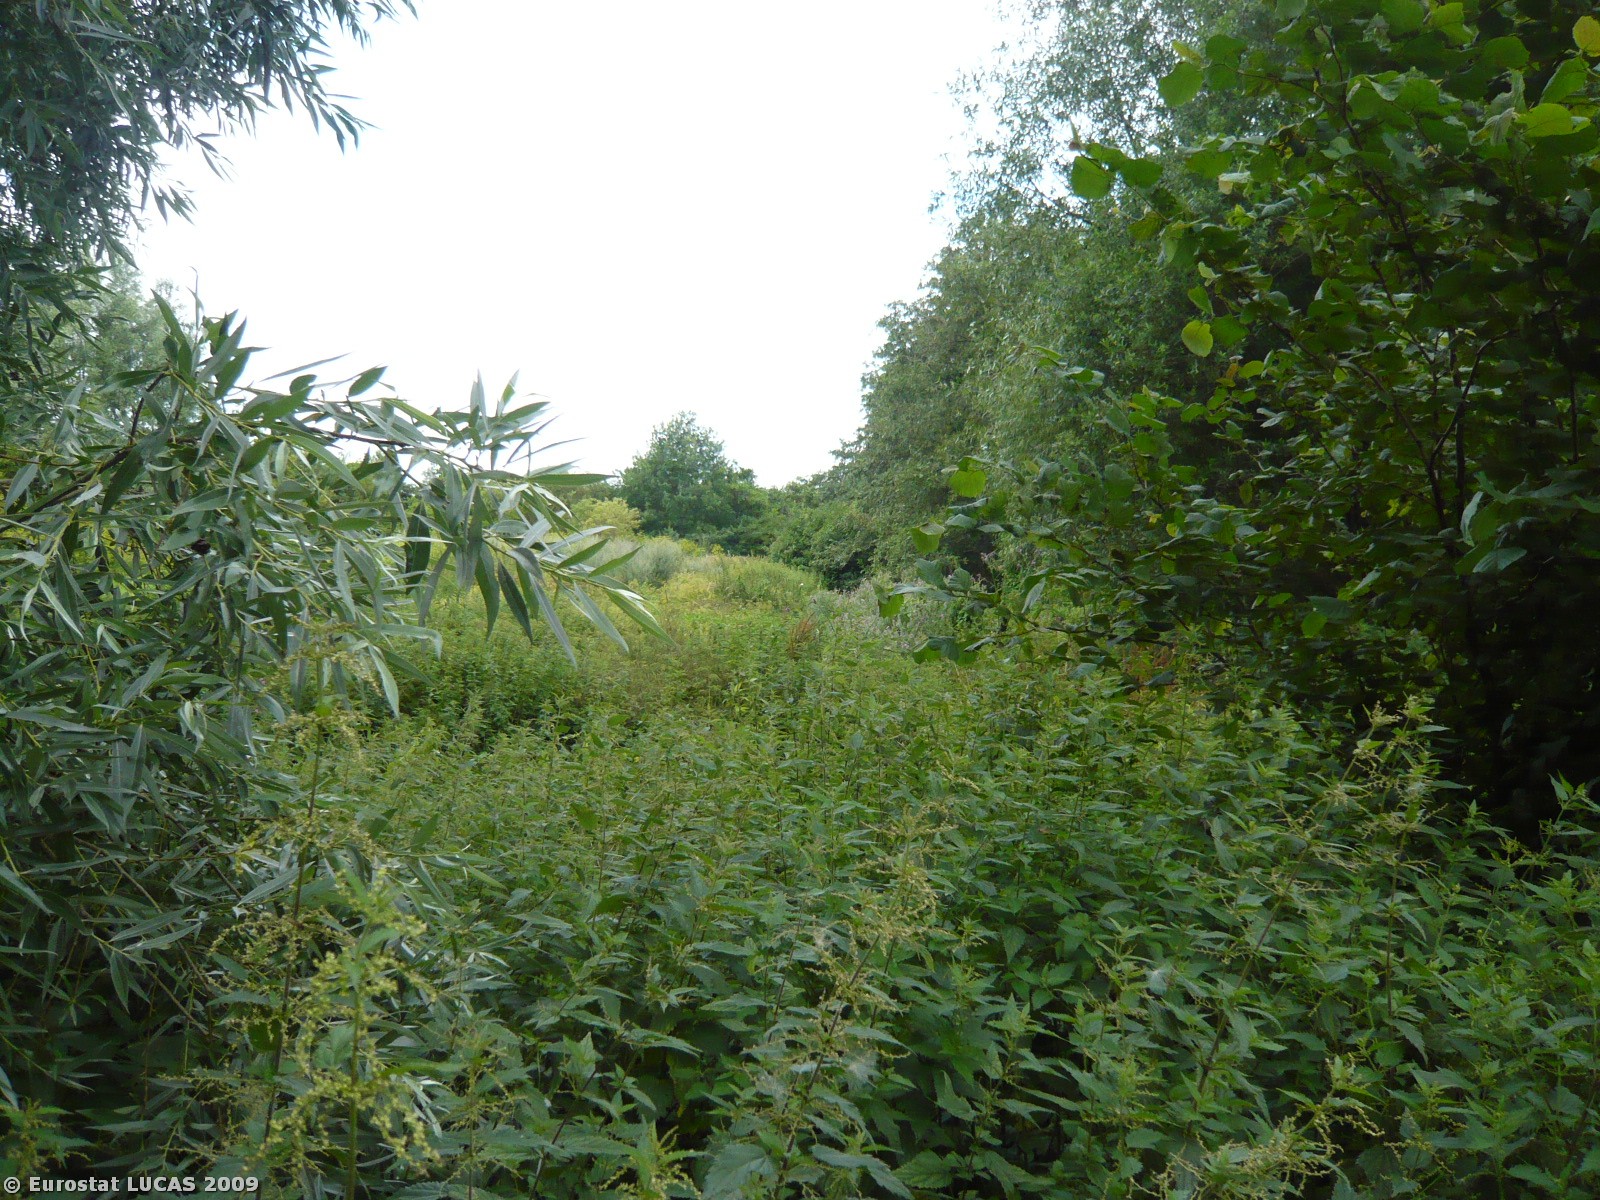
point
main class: Woodland
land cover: Broadleaved woodland
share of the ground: > 75 %
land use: Unused
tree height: < 5 m
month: July
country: DK
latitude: 55.4862
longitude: 12.1663
